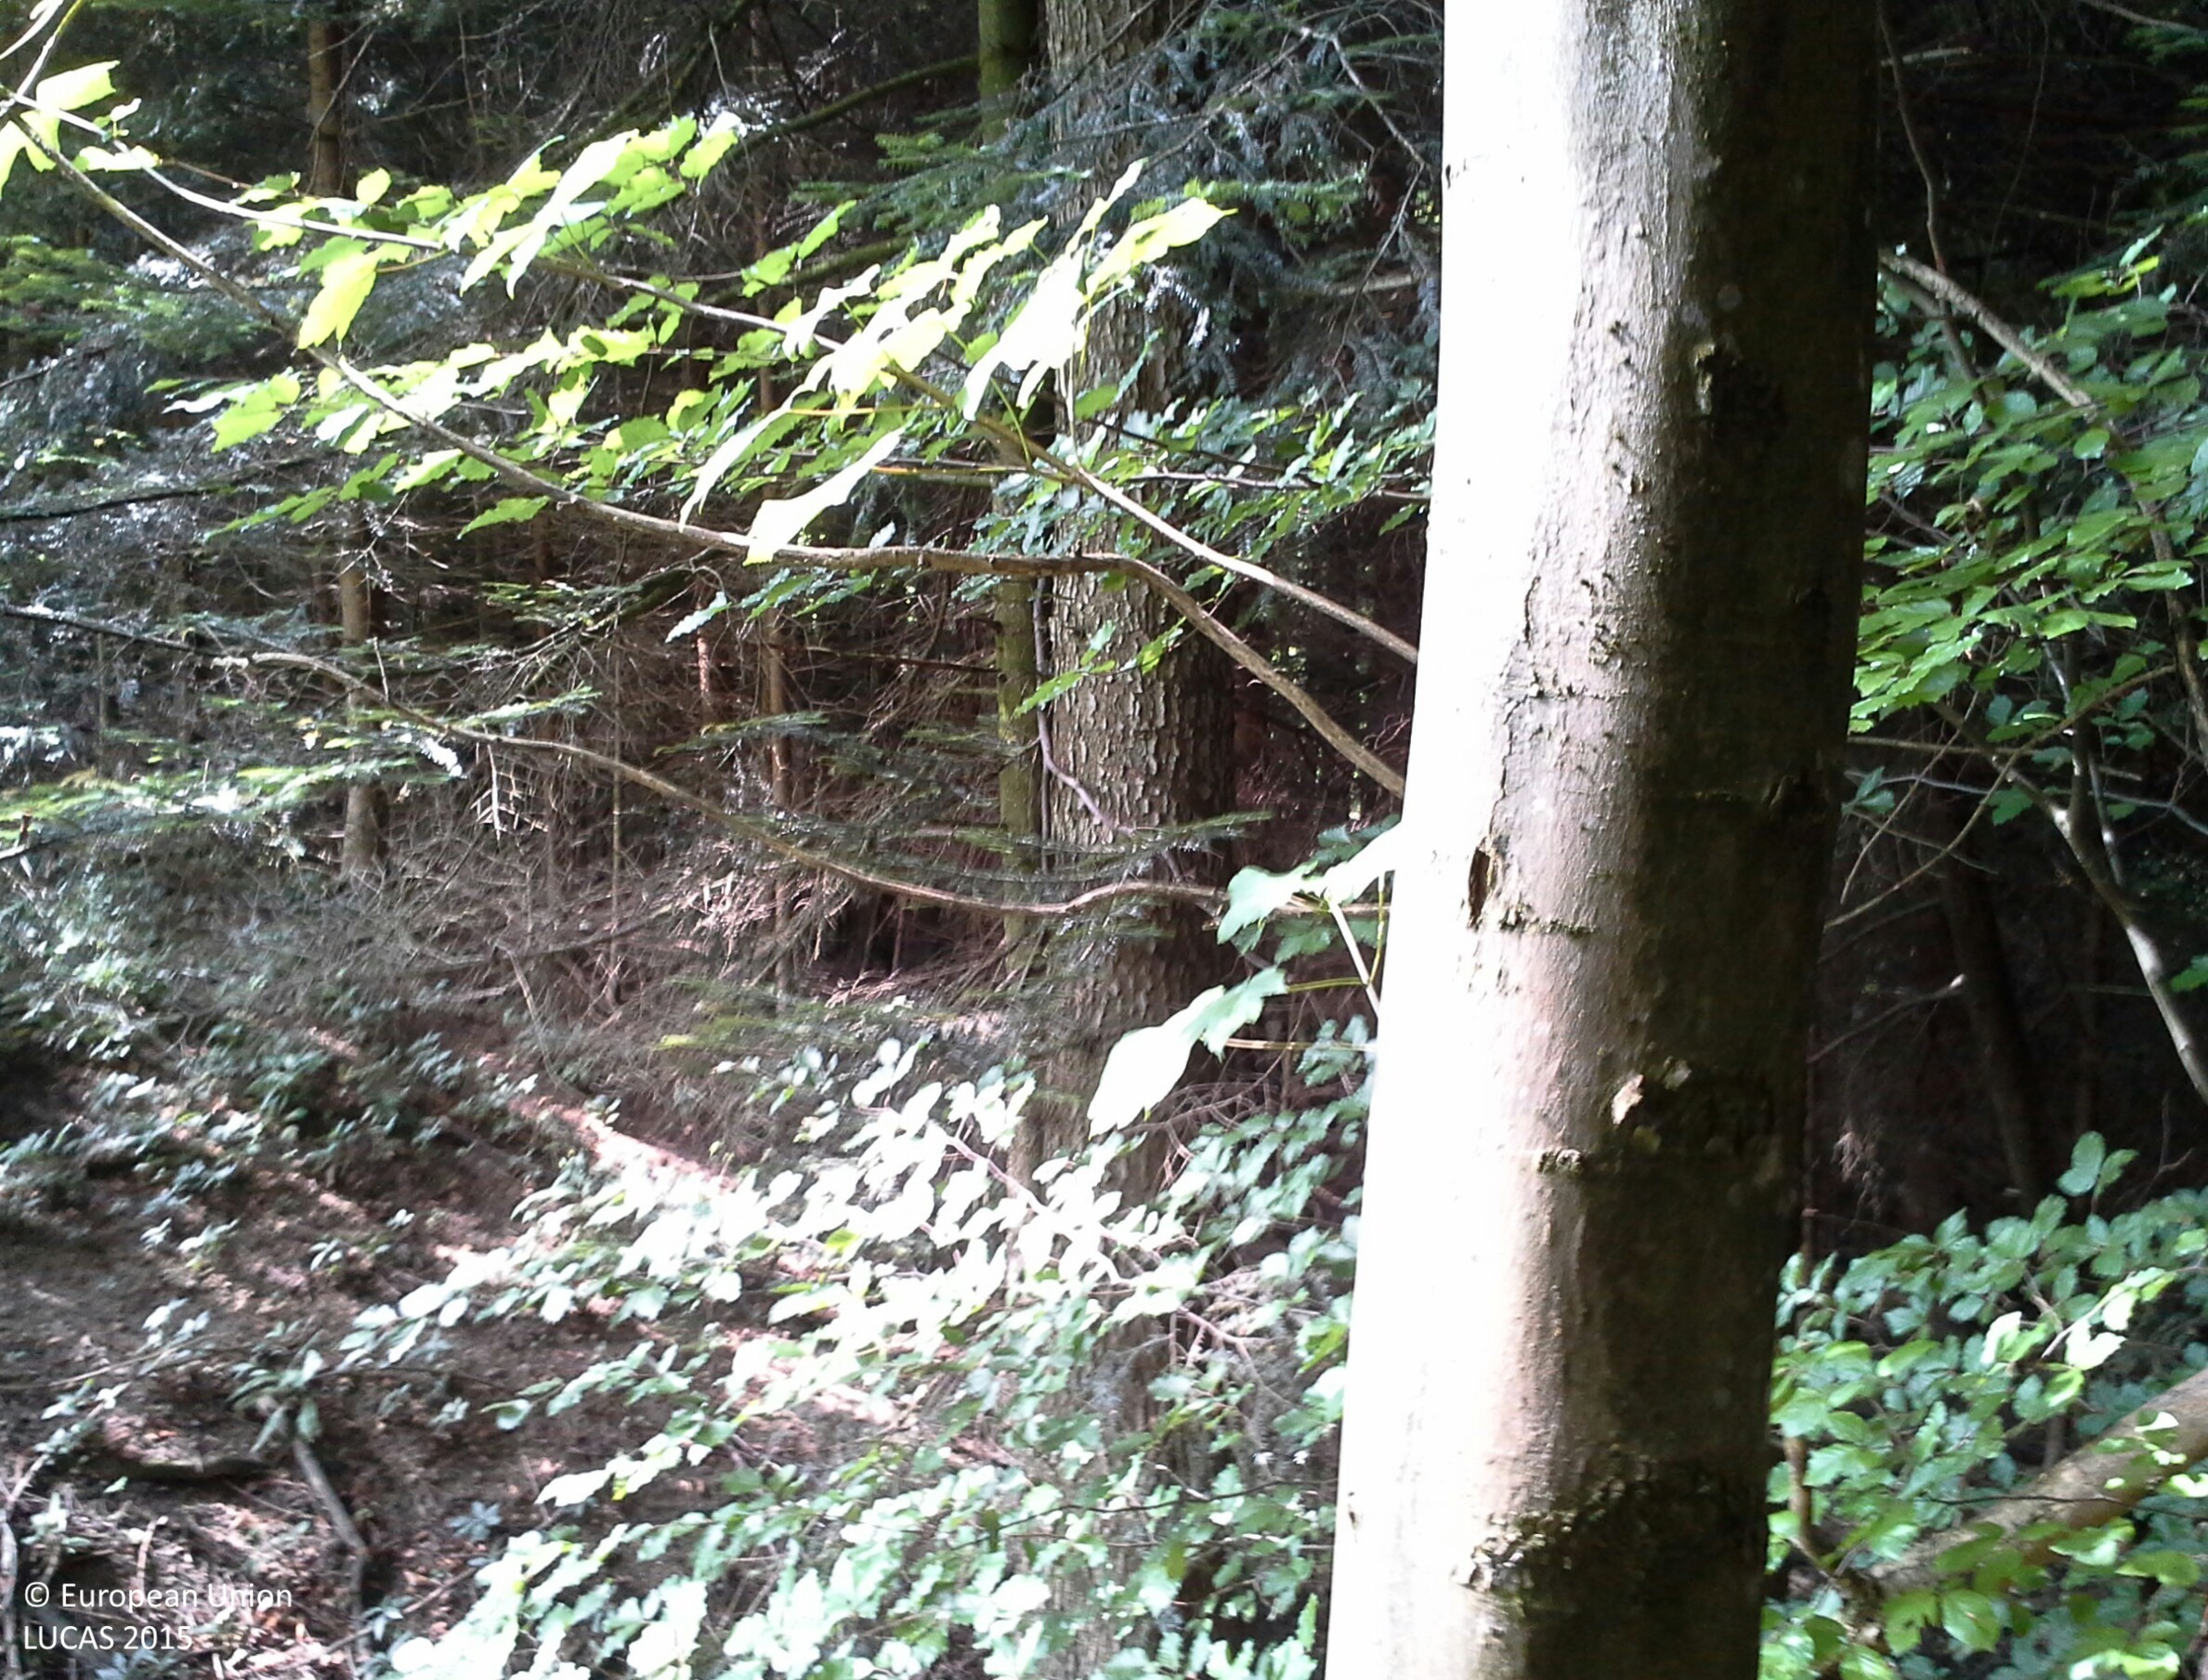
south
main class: Woodland
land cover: Spruce dominated mixed woodland
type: beech forest
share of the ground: > 75 %
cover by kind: coniferous forest trees 70 %, broadleaved forest trees 25 %, herbaceous plants 5 %
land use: Forestry
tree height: > 5 m
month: July
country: AT
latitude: 47.9847
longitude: 14.5690
